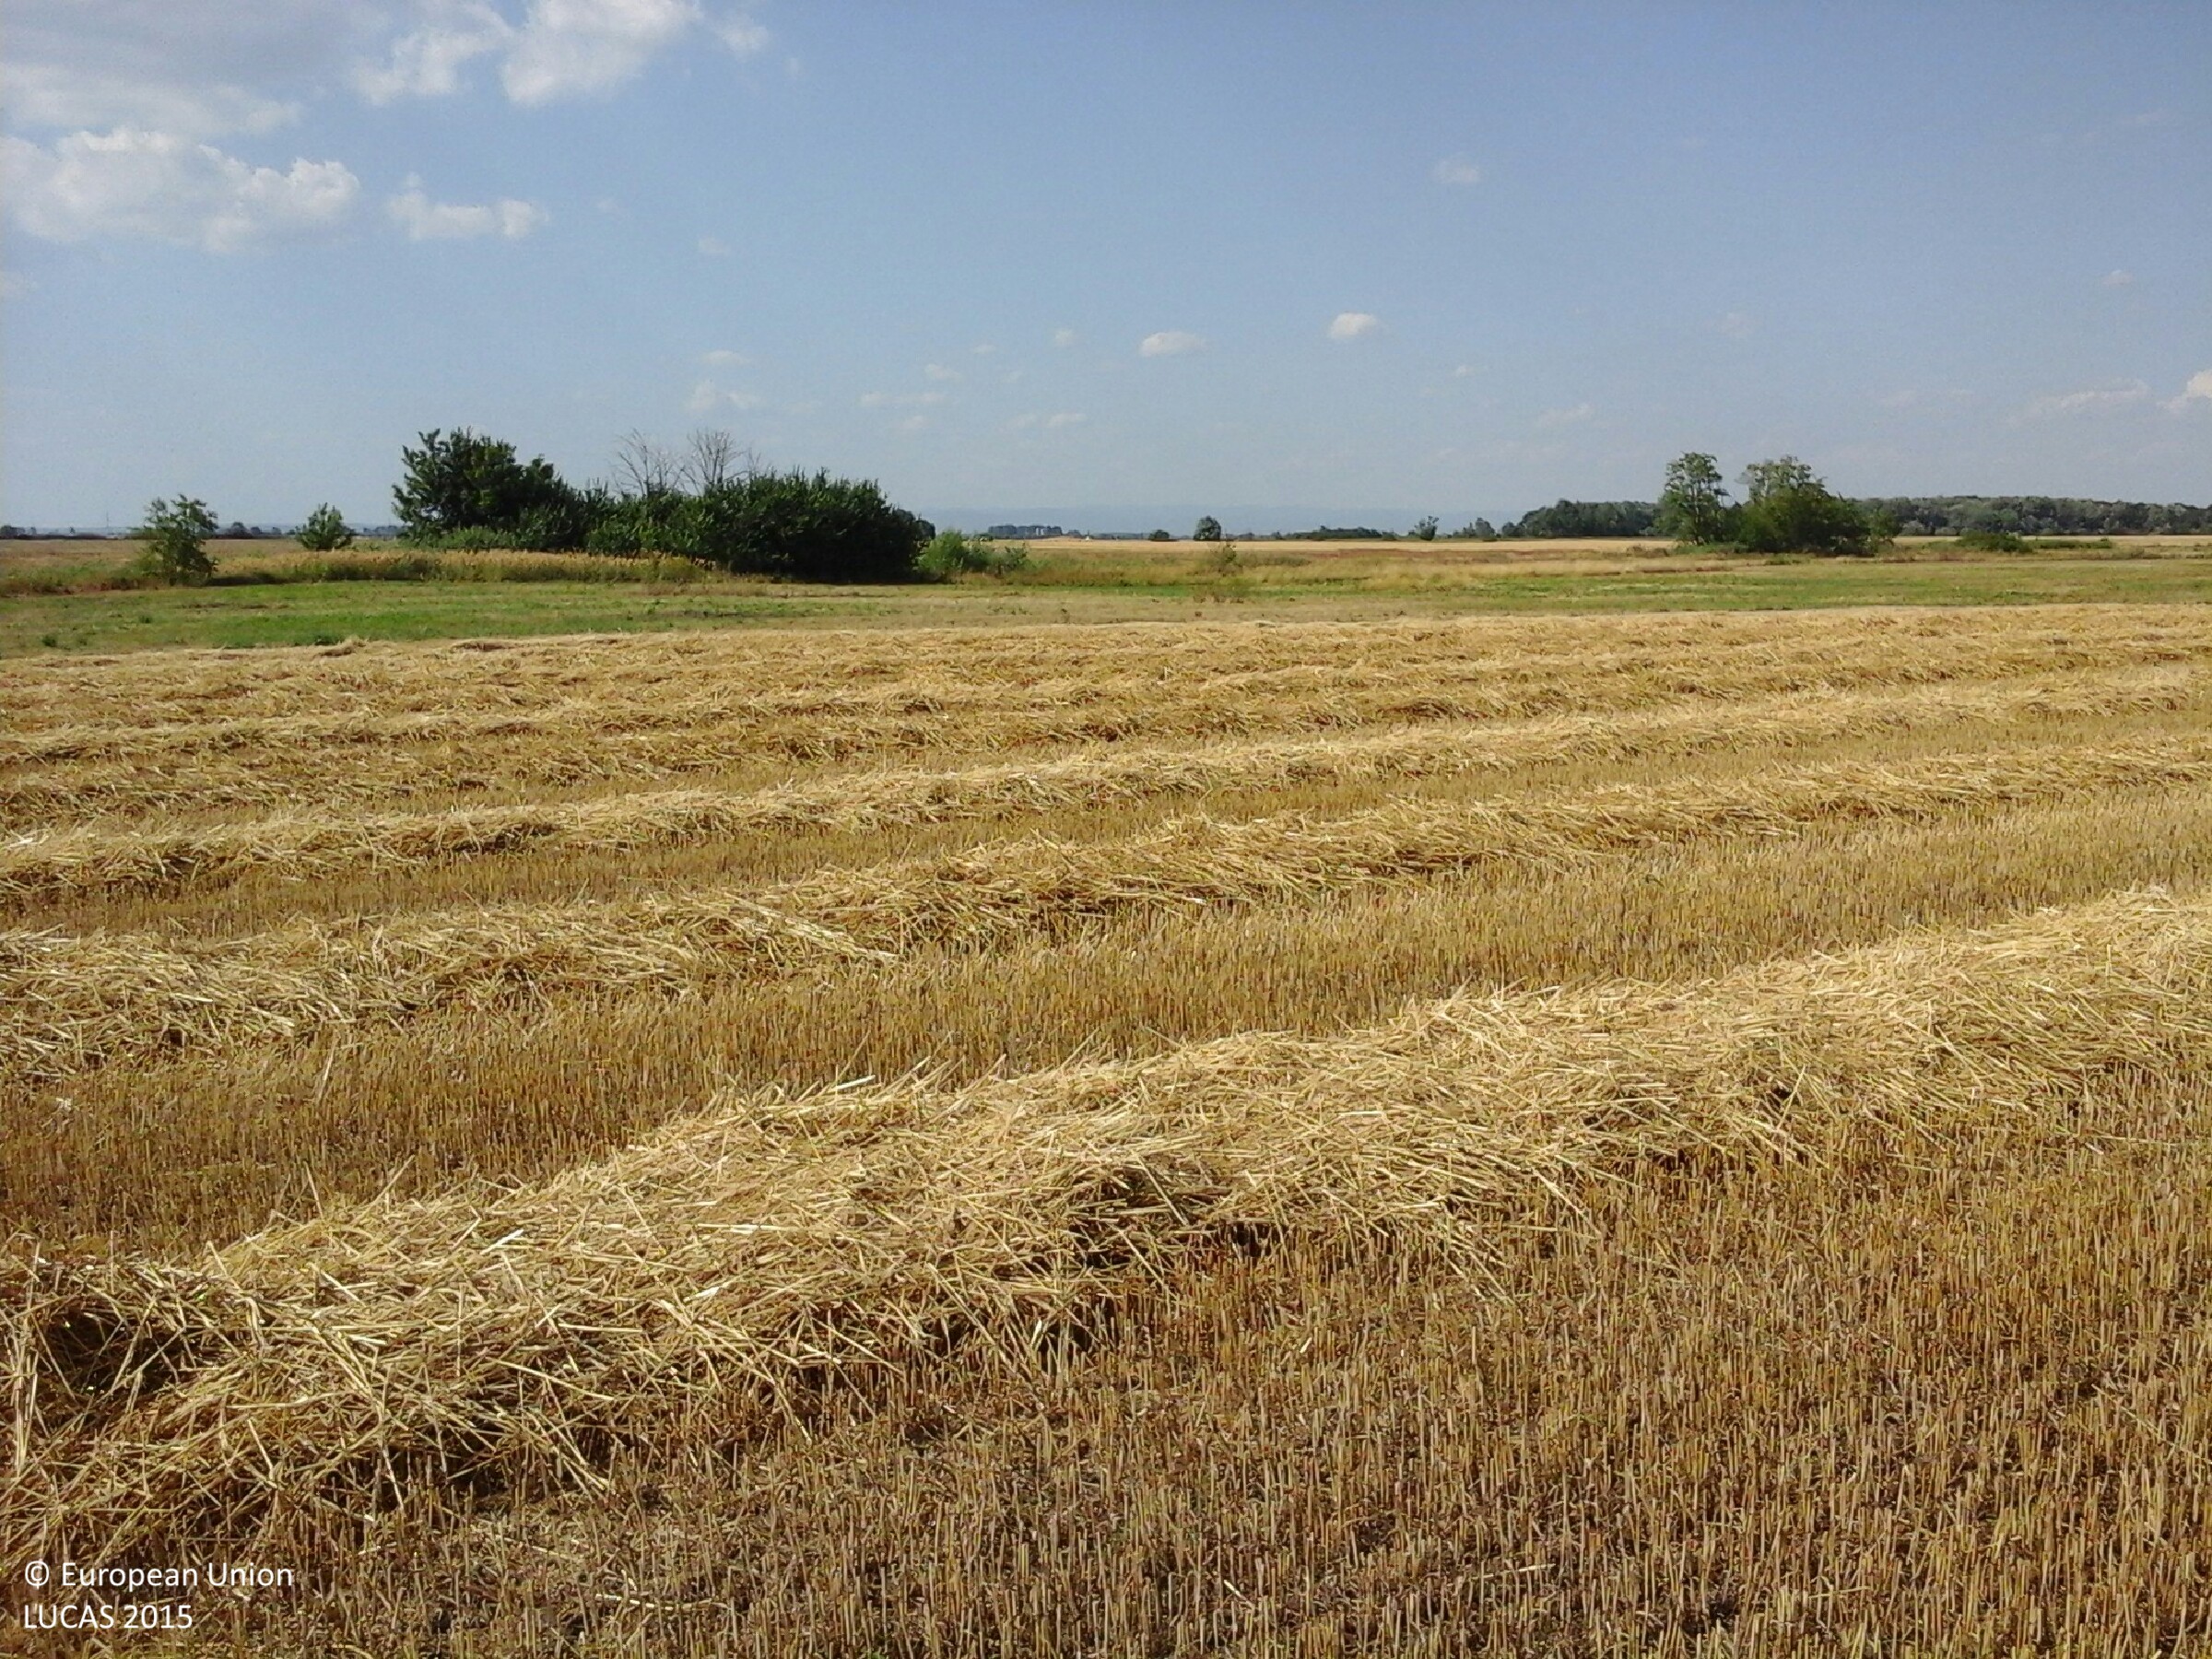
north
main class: Cropland
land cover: Common wheat
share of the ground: 50 - 75 %
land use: Agriculture (excluding fallow land and kitchen gardens)
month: July
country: HU
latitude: 47.6498
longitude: 20.4822
